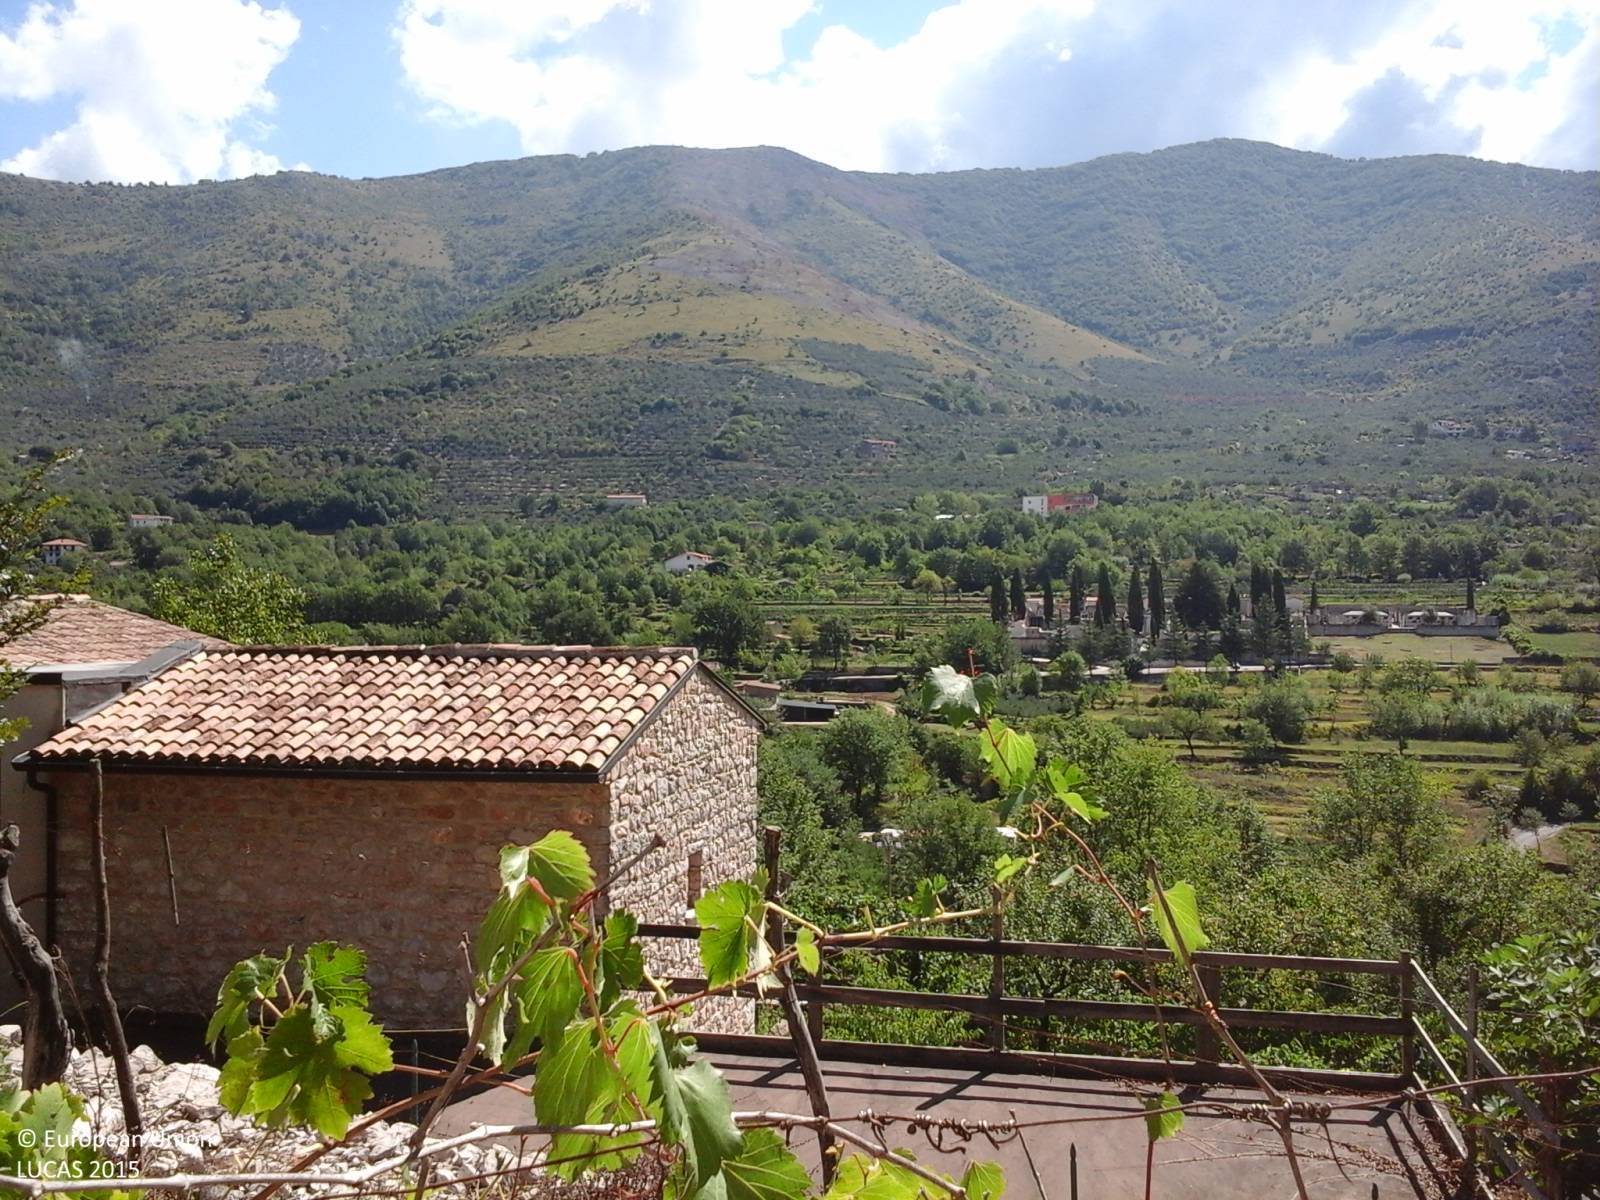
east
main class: Cropland
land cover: Vineyards
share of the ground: 25 - 50 %
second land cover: Spontaneously vegetated surfaces
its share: > 75 %
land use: Agriculture (excluding fallow land and kitchen gardens)
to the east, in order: Vineyards; Spontaneously vegetated surfaces; Dry stone walls; Spontaneously vegetated surfaces; Artificial constructions in urban areas; Vineyards; Spontaneously vegetated surfaces; Fences; Abandoned hedges; Grassland without tree/shrub cover; Abandoned hedges; Grassland without tree/shrub cover; Abandoned hedges; Spontaneously vegetated surfaces; Abandoned hedges; Lucerne; Shruby margins; Temporary grasslands; Vineyards; Electric lines; Spontaneously vegetated surfaces; Broadleaved woodland; Paved roads, cycling and walking lanes; Broadleaved woodland; Inland fresh running water; Broadleaved woodland; Spontaneously vegetated surfaces; Dry stone walls; Spontaneously vegetated surfaces; Dry stone walls
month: August
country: IT
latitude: 41.4577
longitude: 13.3987
